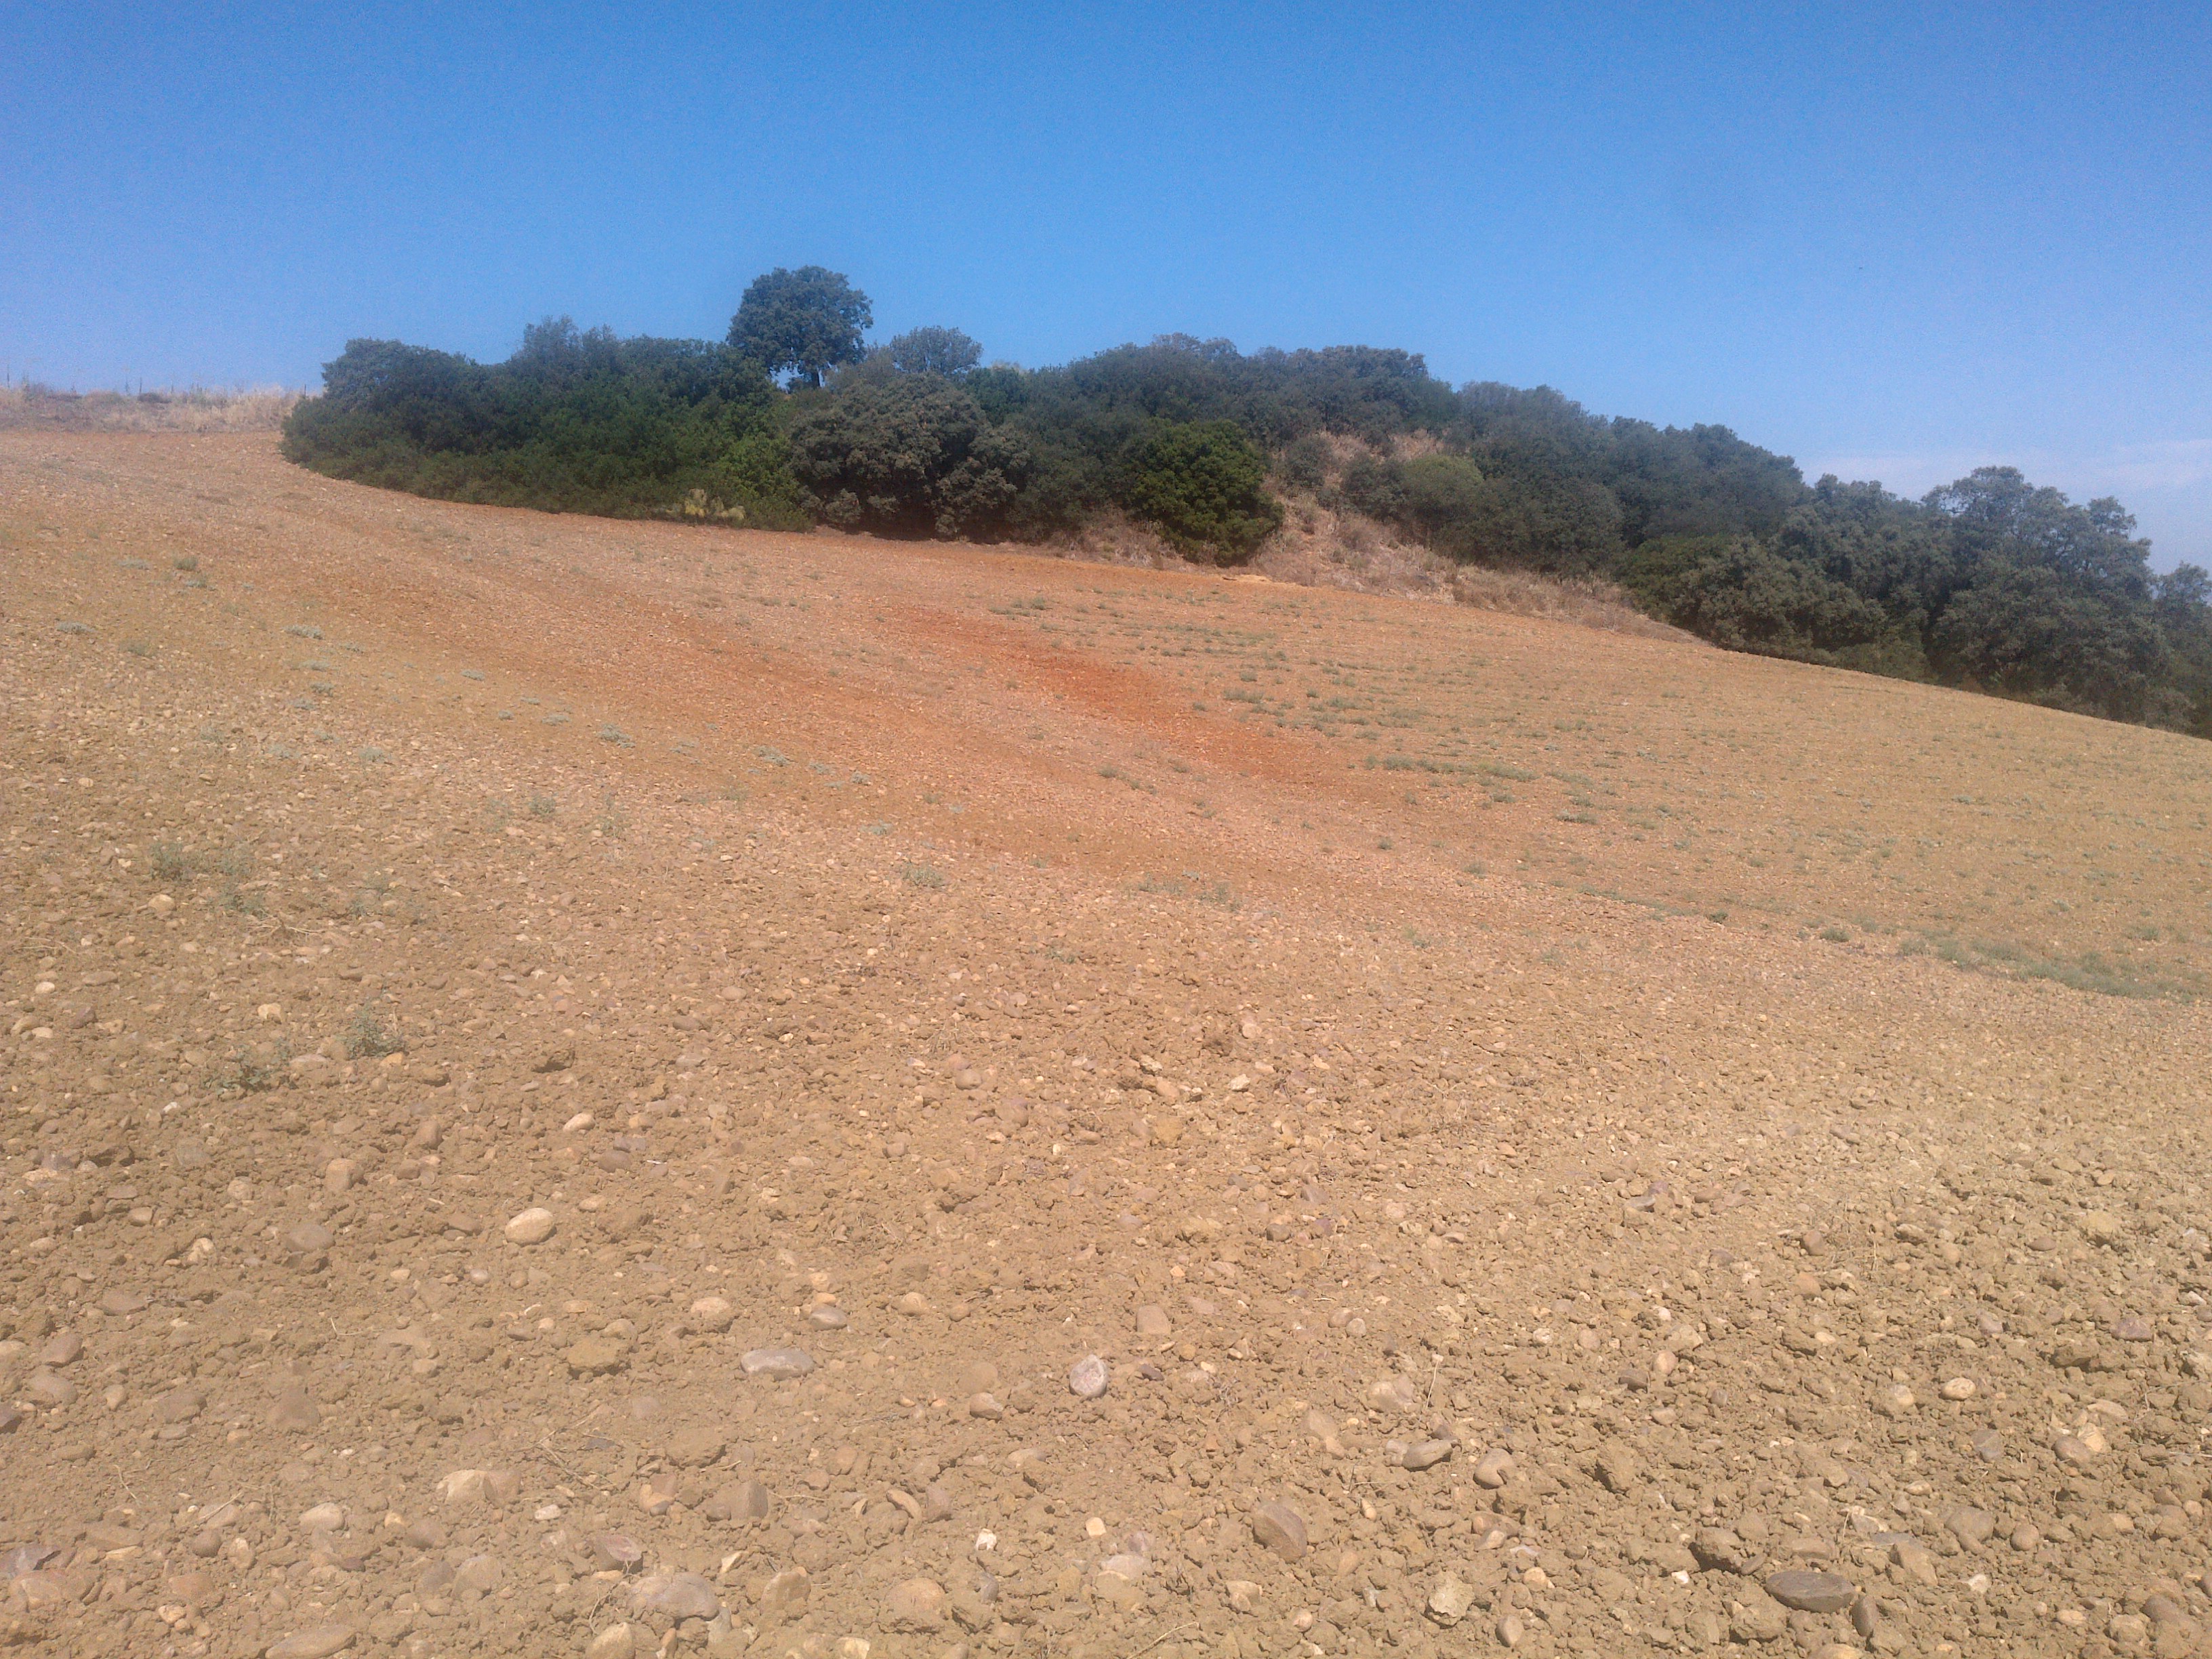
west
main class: Woodland
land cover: Broadleaved woodland
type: broadleaved evergreen forest
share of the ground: 25 - 50 %
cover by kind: shrubs 50 %, broadleaved forest trees 25 %, unconsolidated bare surface 15 %, herbaceous plants 10 %
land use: Semi-natural and natural areas not in use
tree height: < 5 m
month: June
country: ES
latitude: 37.7241
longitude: -4.9101
